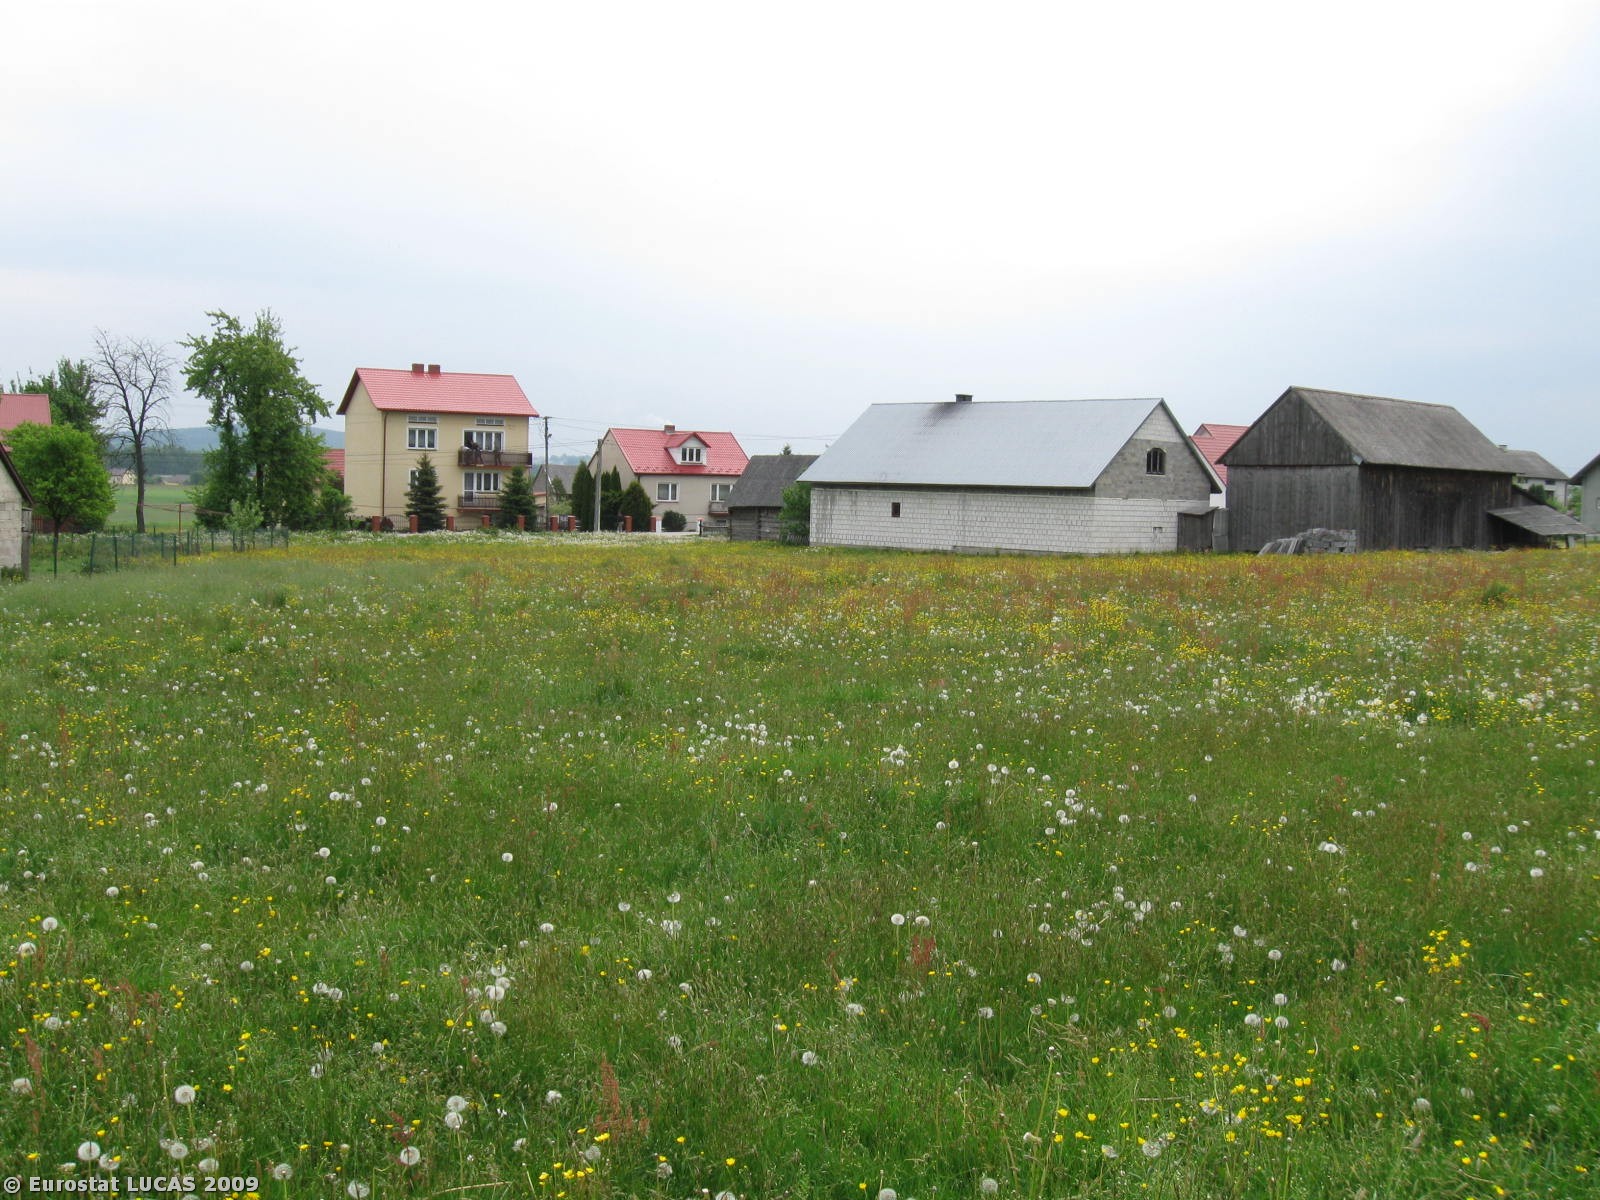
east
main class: Grassland
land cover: Grassland without tree/shrub cover
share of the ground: > 75 %
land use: Agriculture (excluding fallow land and kitchen gardens)
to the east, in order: Grassland without tree/shrub cover; Artificial constructions in urban areas; Fences; Grassland without tree/shrub cover; Managed hedges; Fences; Apple fruit; Grassland with sparse tree/shrub cover; Spontaneously vegetated surfaces; Grass margins; Fences; Grass margins
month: May
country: PL
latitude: 50.9316
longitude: 20.4963
